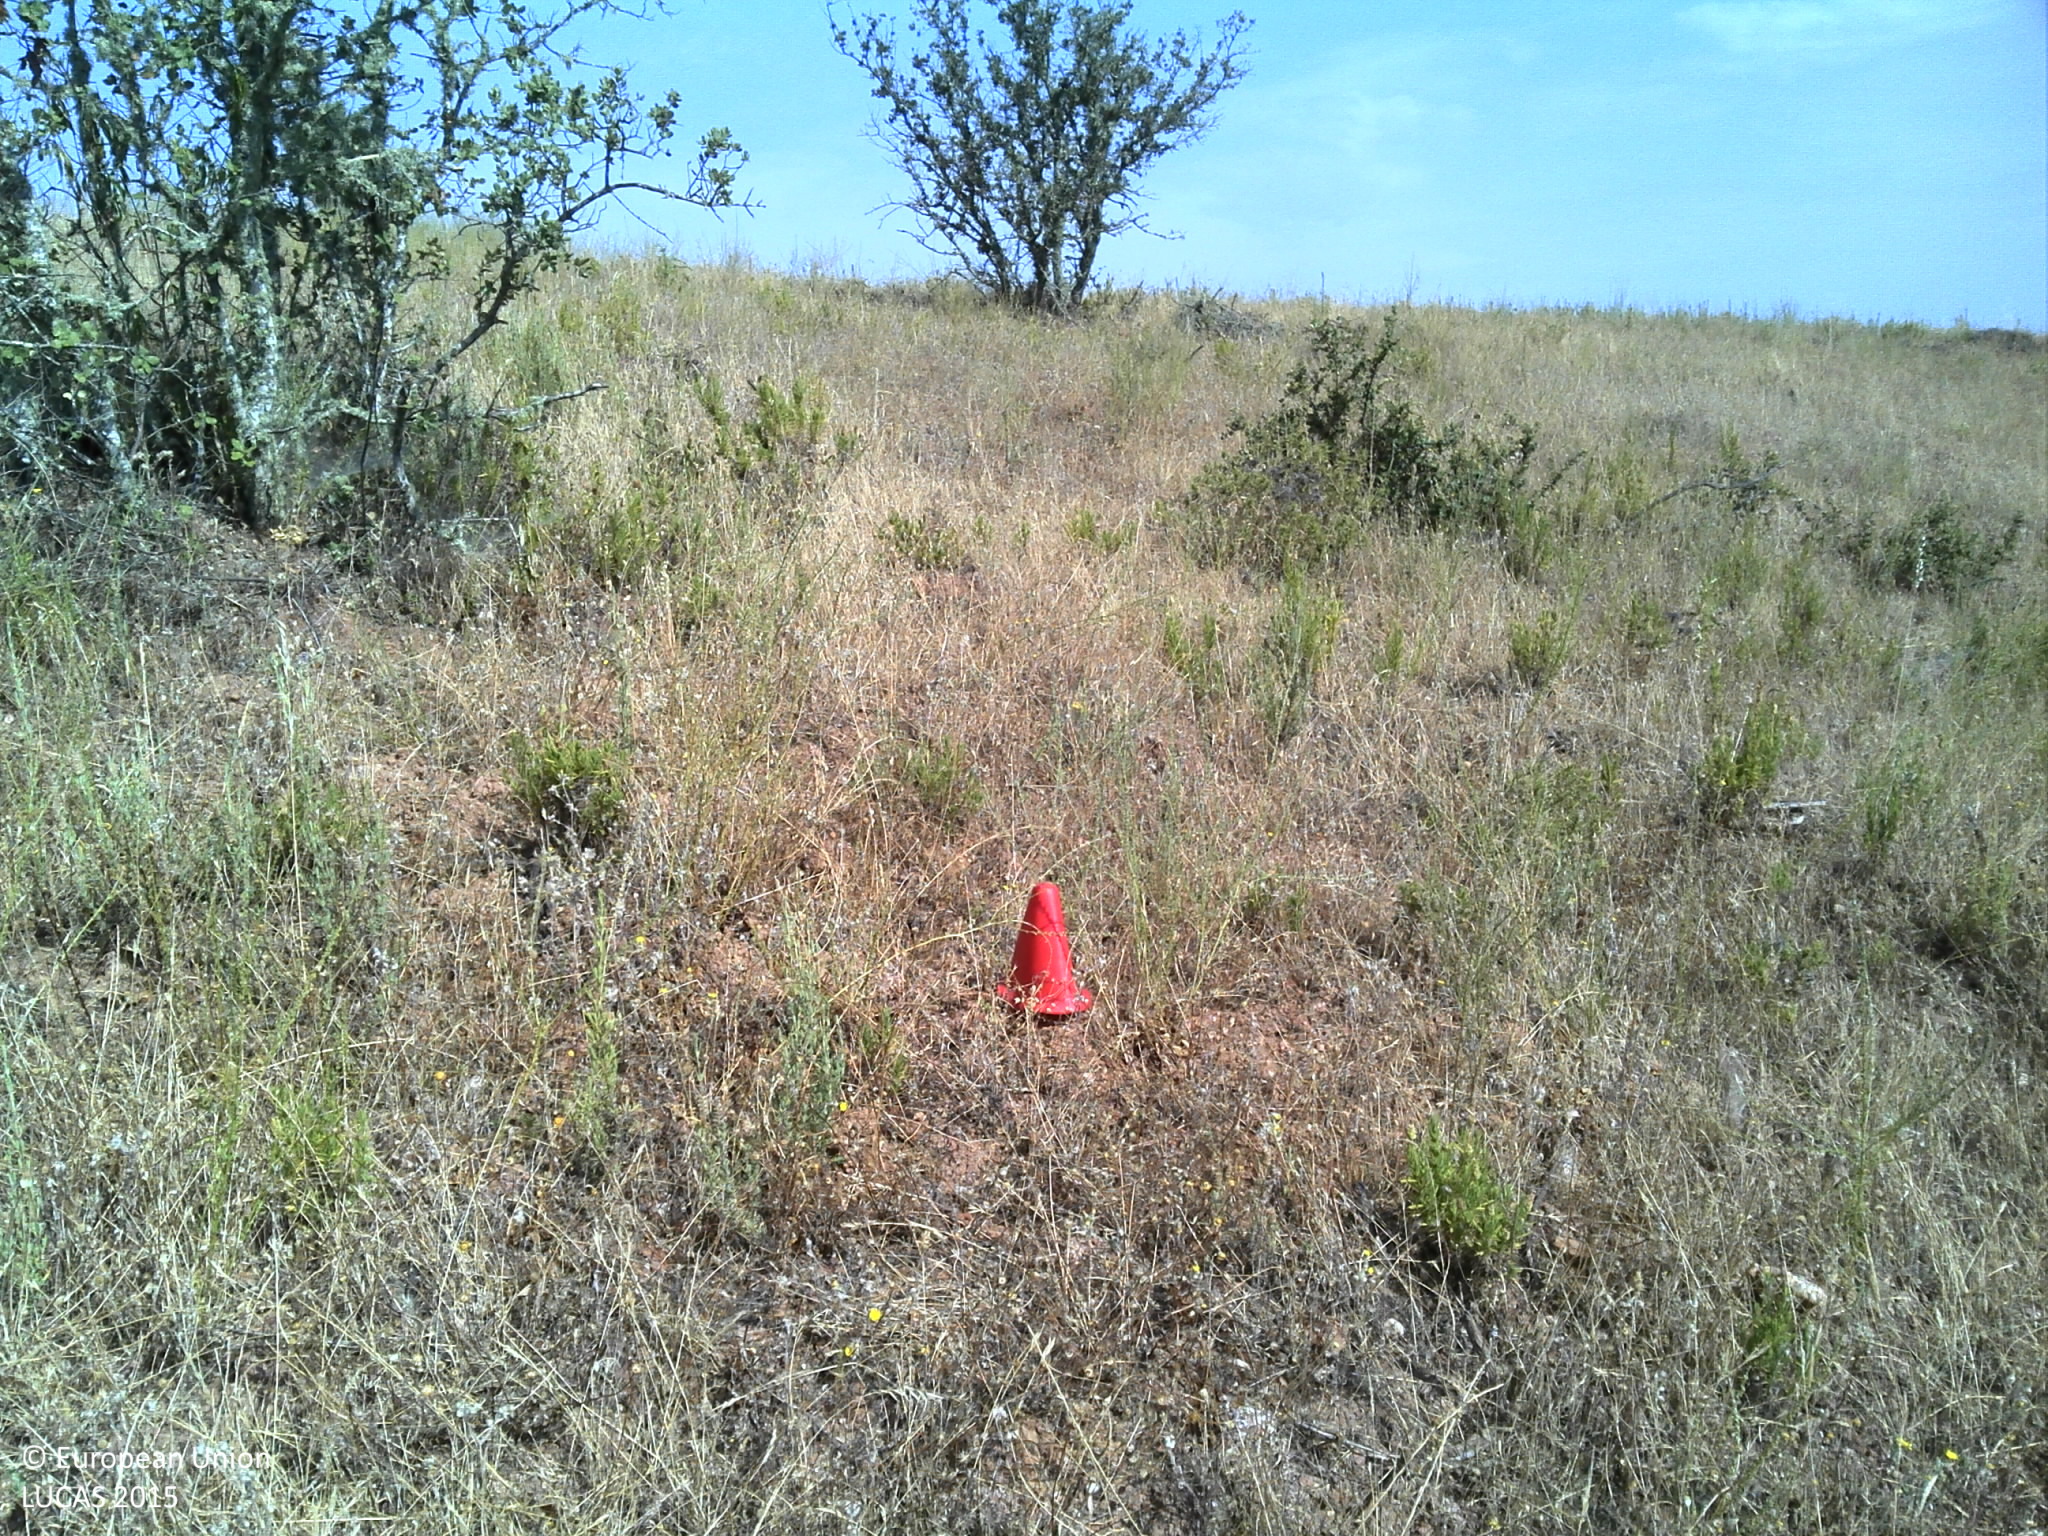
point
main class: Grassland
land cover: Grassland with sparse tree/shrub cover
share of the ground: 50 - 75 %
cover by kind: herbaceous plants 95 %, broadleaved forest trees 5 %
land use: Agriculture (excluding fallow land and kitchen gardens)
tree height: < 5 m
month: June
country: PT
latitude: 37.7776
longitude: -7.4879
